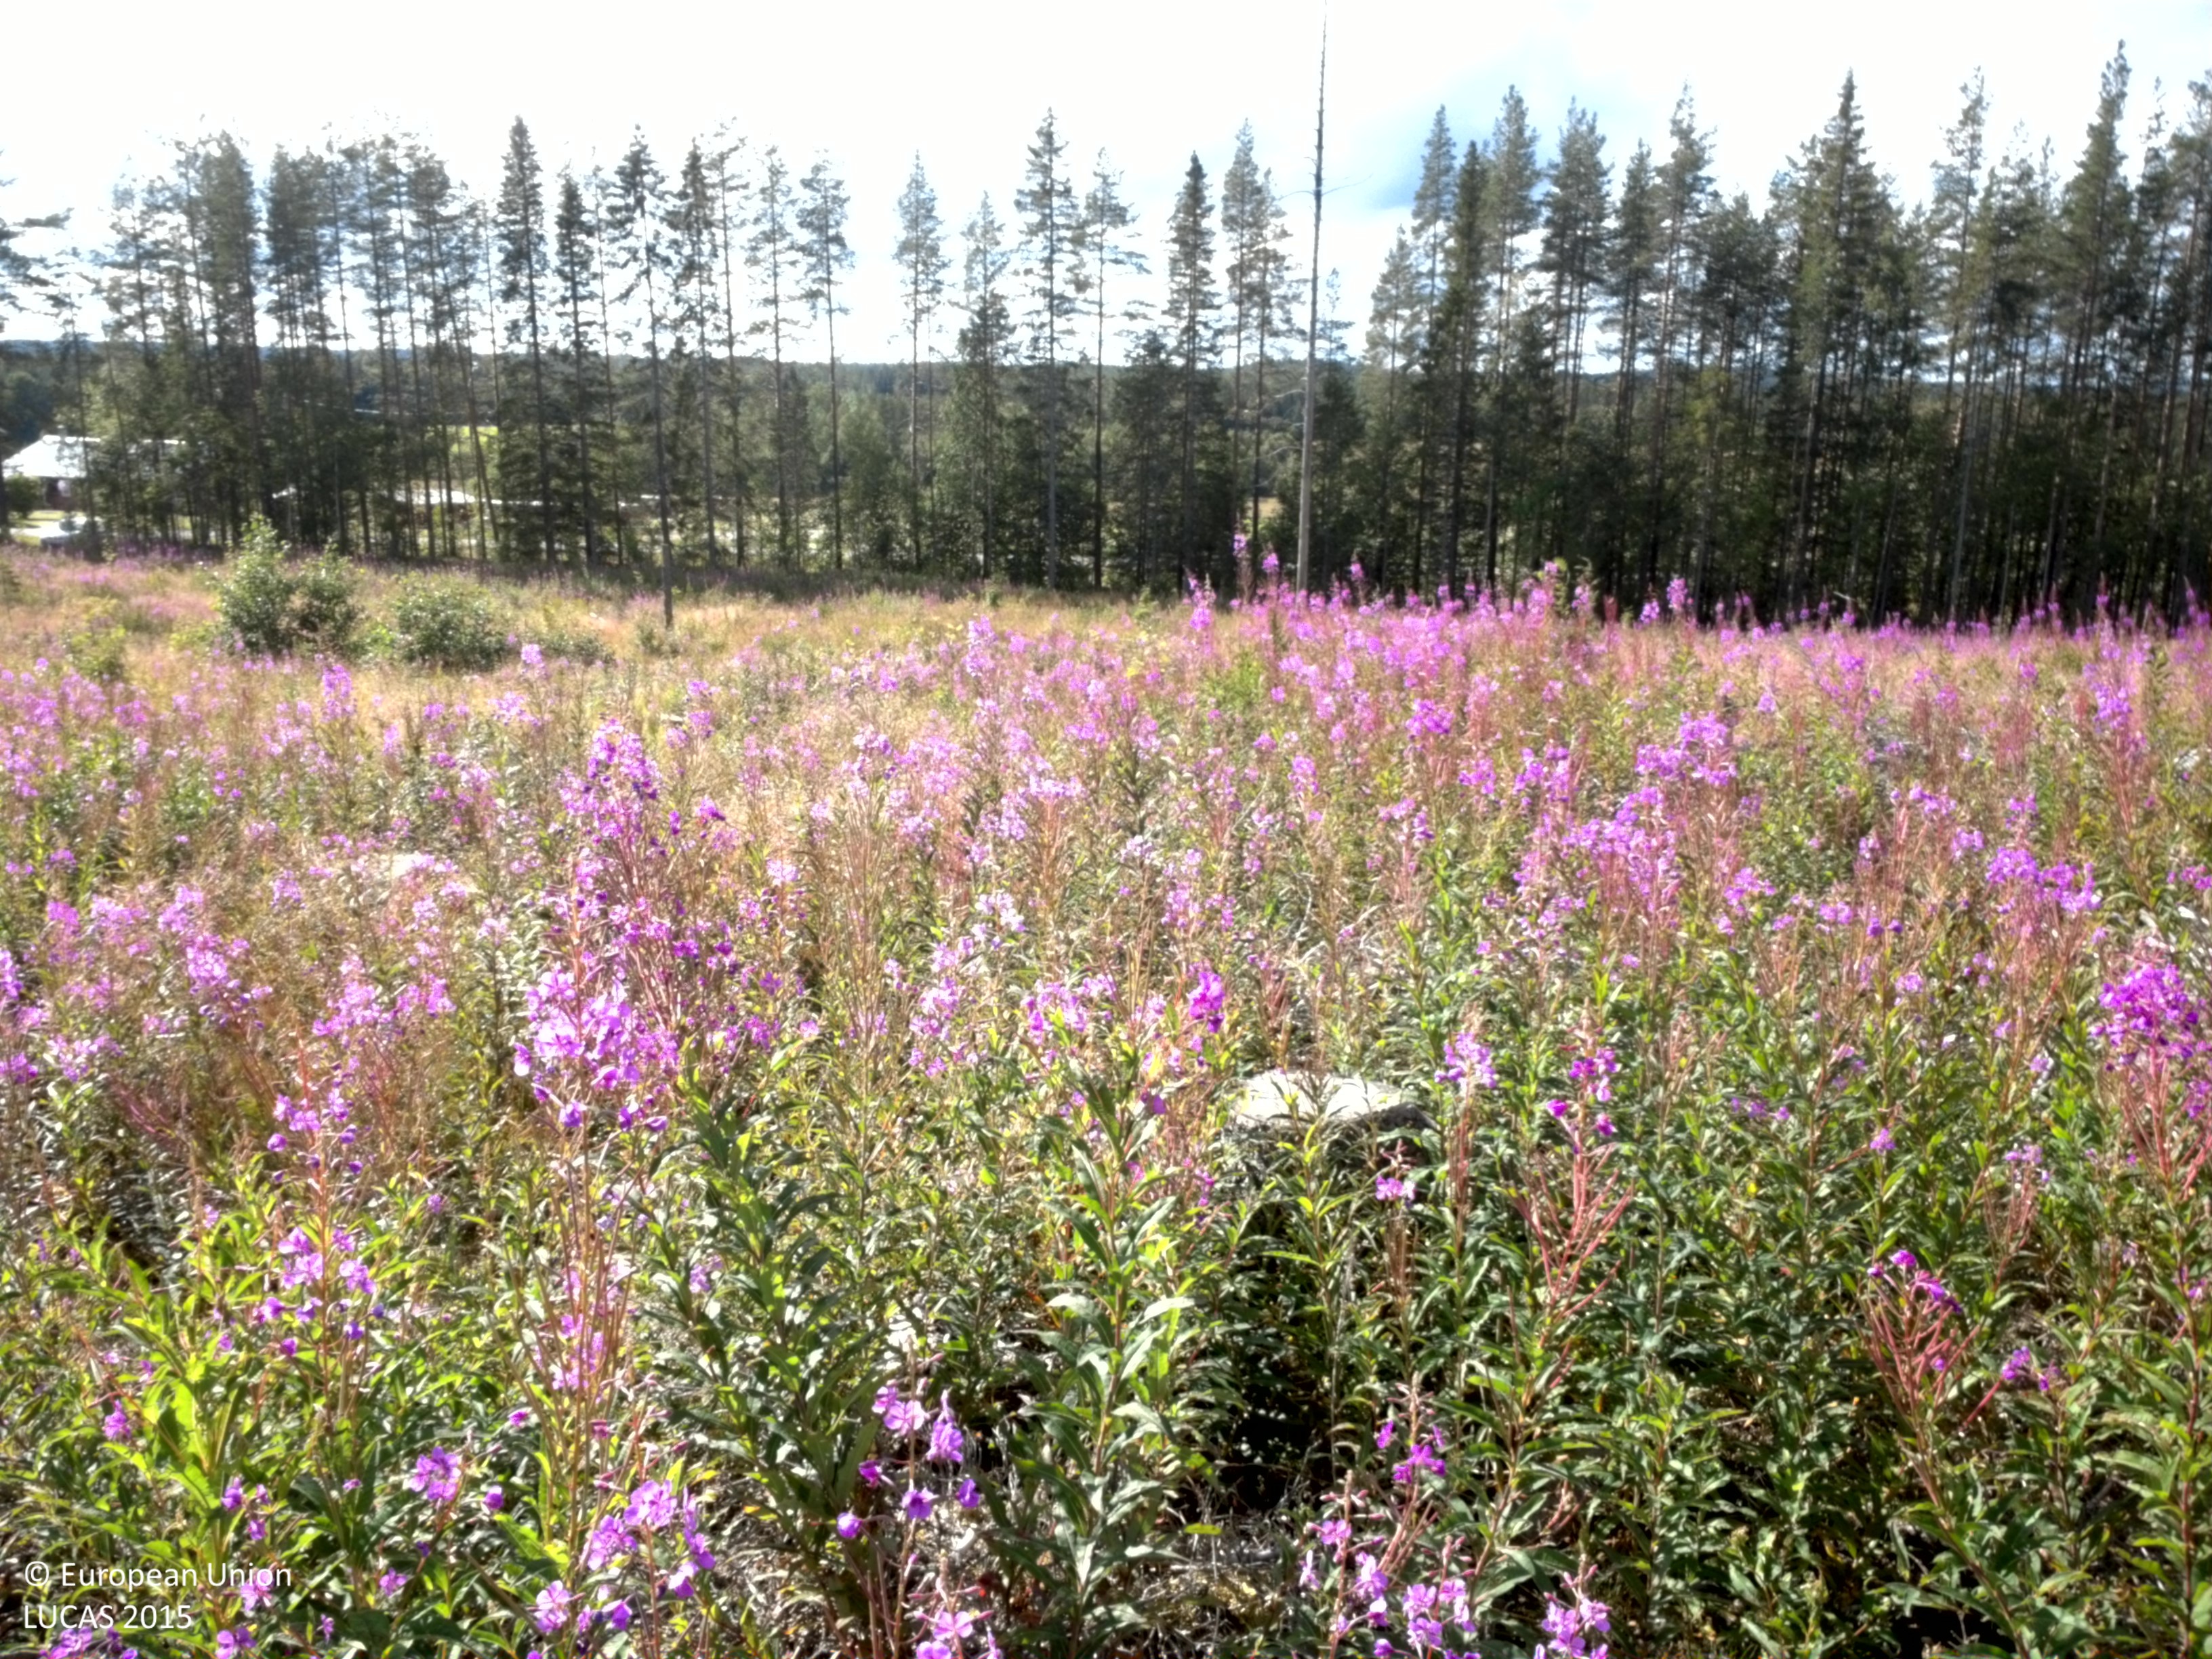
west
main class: Grassland
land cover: Grassland without tree/shrub cover
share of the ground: > 75 %
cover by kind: herbaceous plants 75 %, shrubs 5 %
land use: Forestry
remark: Clear cut
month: August
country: SE
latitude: 64.6469
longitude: 20.8413
